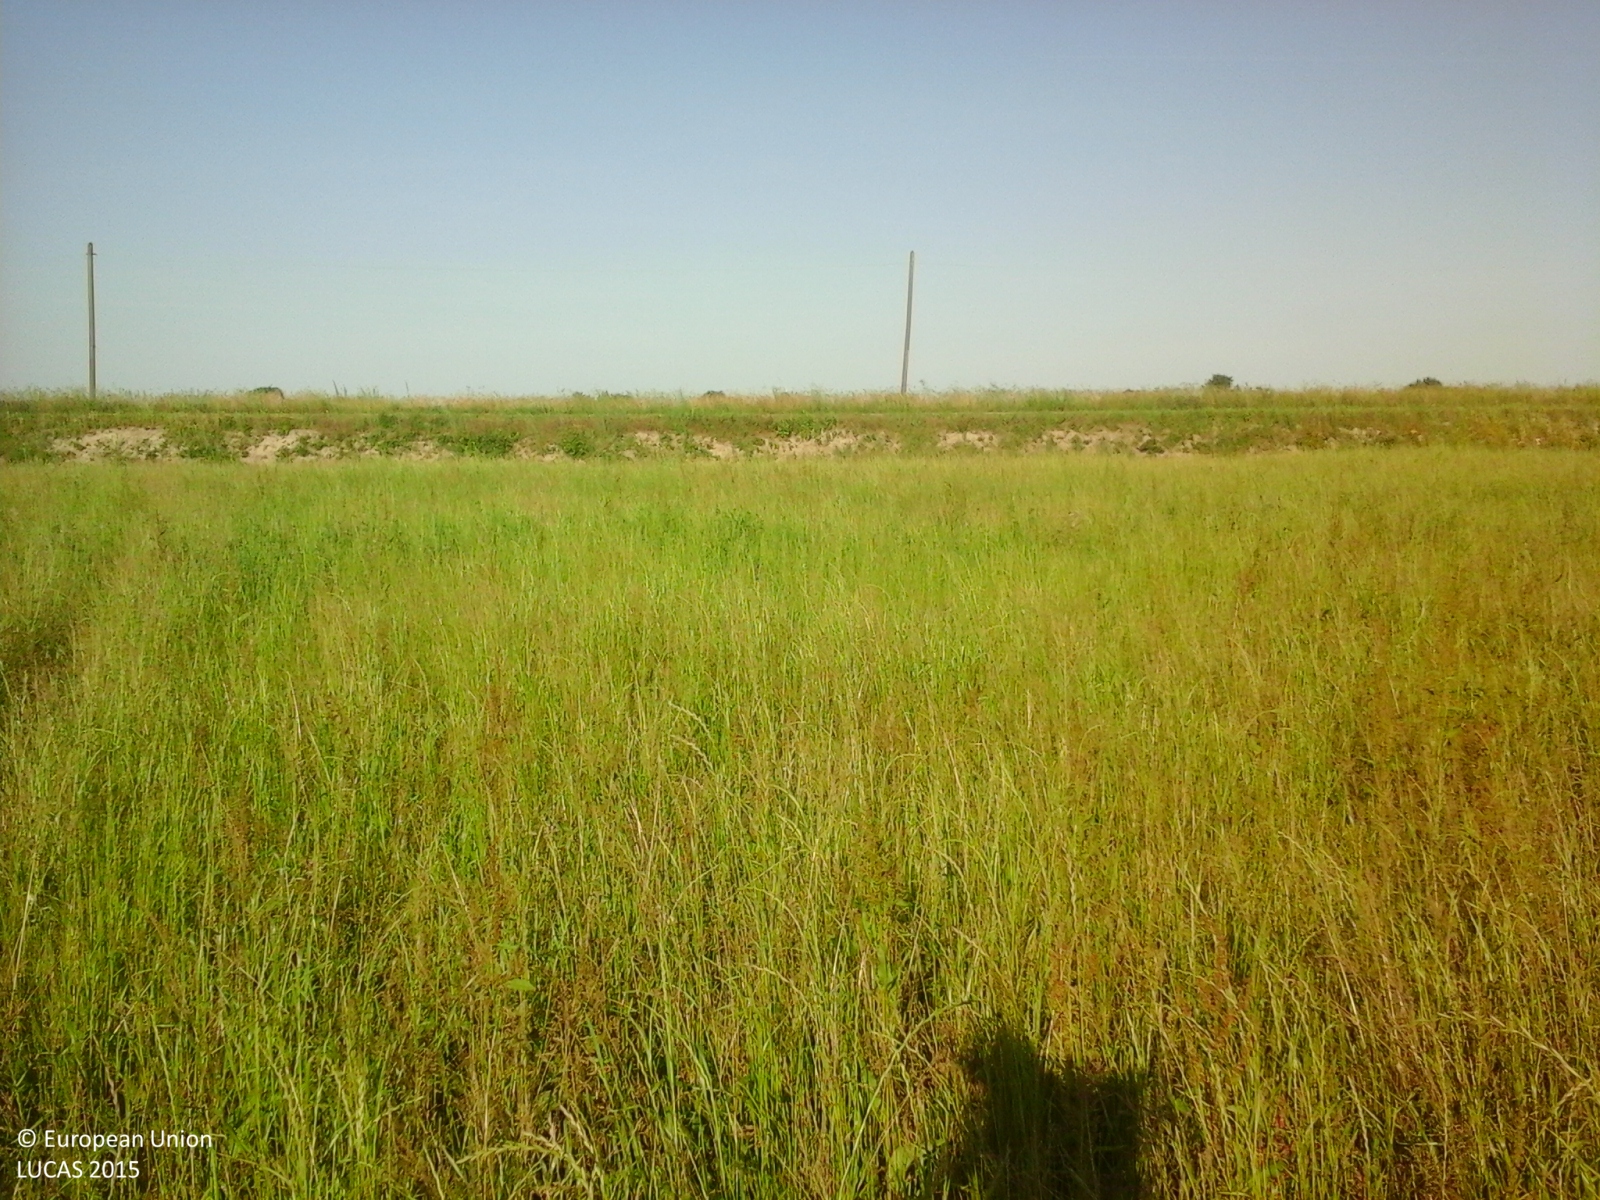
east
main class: Cropland
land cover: Temporary grasslands
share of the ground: > 75 %
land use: Agriculture (excluding fallow land and kitchen gardens)
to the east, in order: Temporary grasslands; Ditches and canals; Grass margins; Paved roads, cycling and walking lanes; Grass margins; Electric lines; Temporary grasslands
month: May
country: IT
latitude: 44.9776
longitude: 10.9239
